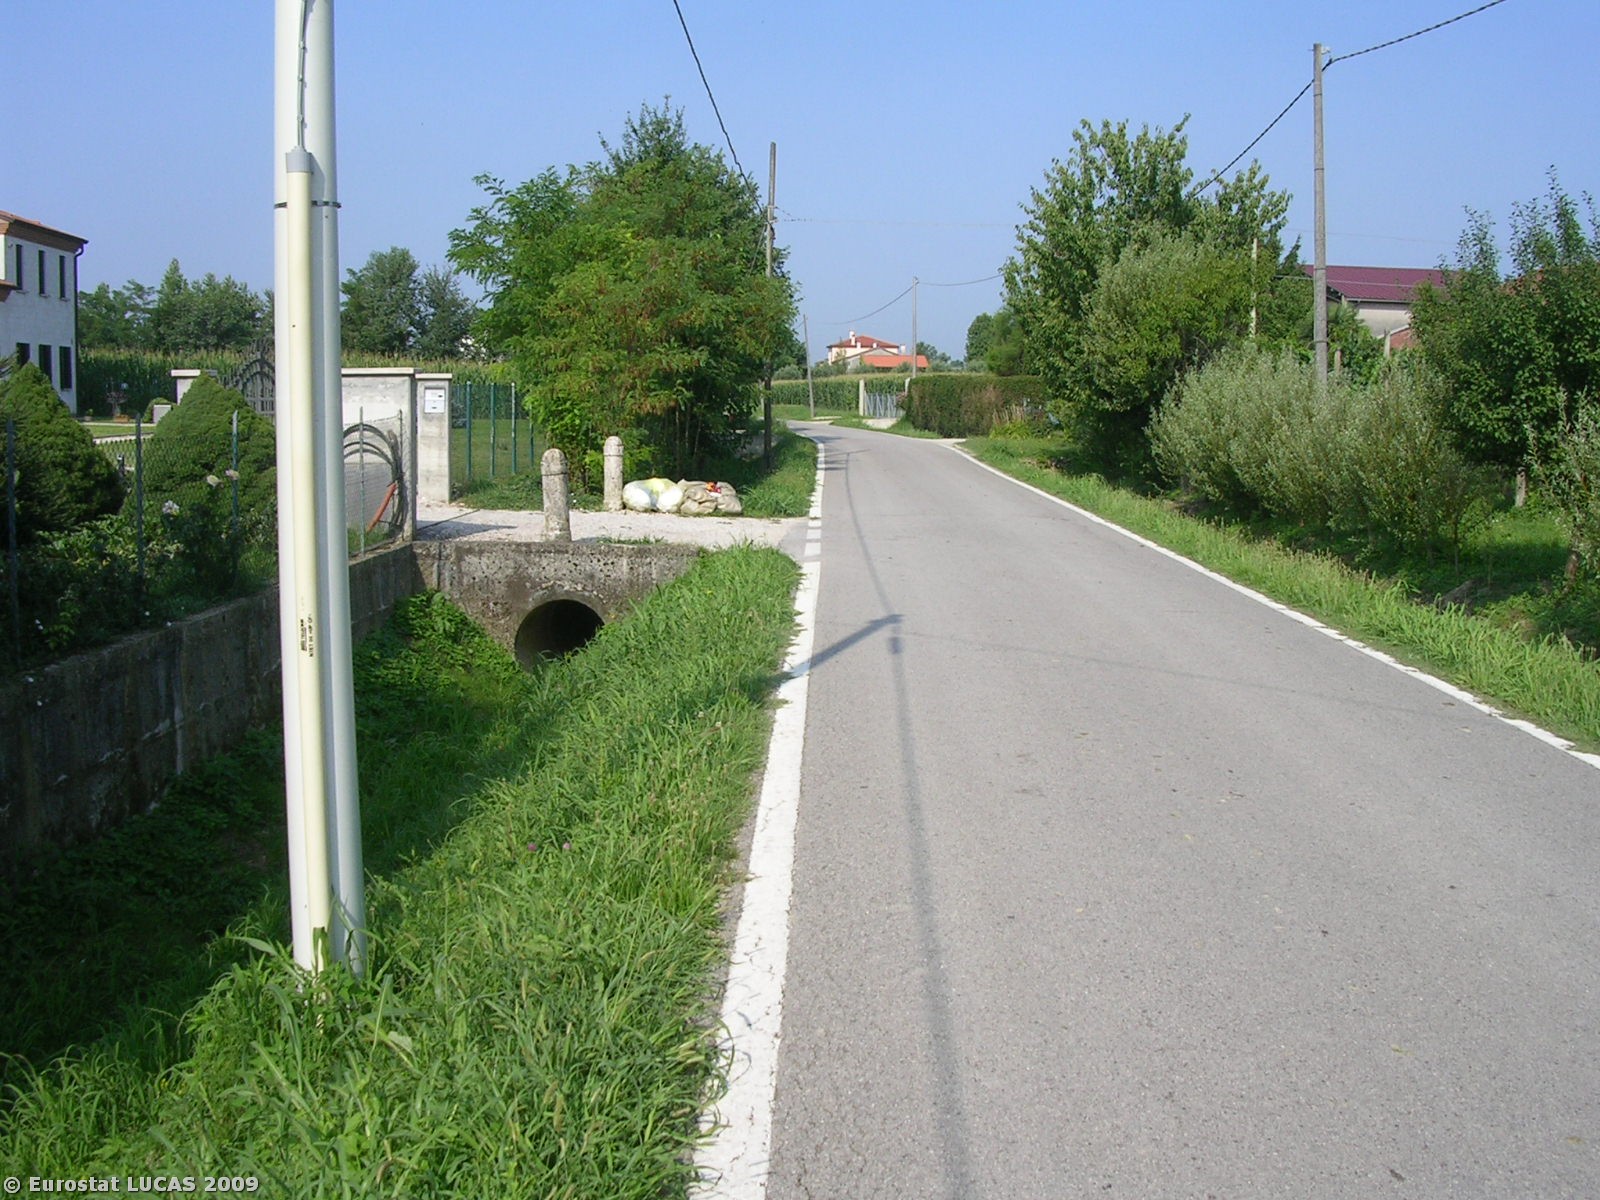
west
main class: Cropland
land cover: Nuts trees
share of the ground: 50 - 75 %
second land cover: Grassland with sparse tree/shrub cover
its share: 50 - 75 %
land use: Agriculture (excluding fallow land and kitchen gardens)
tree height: < 5 m
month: July
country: IT
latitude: 45.5440
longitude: 11.7518
